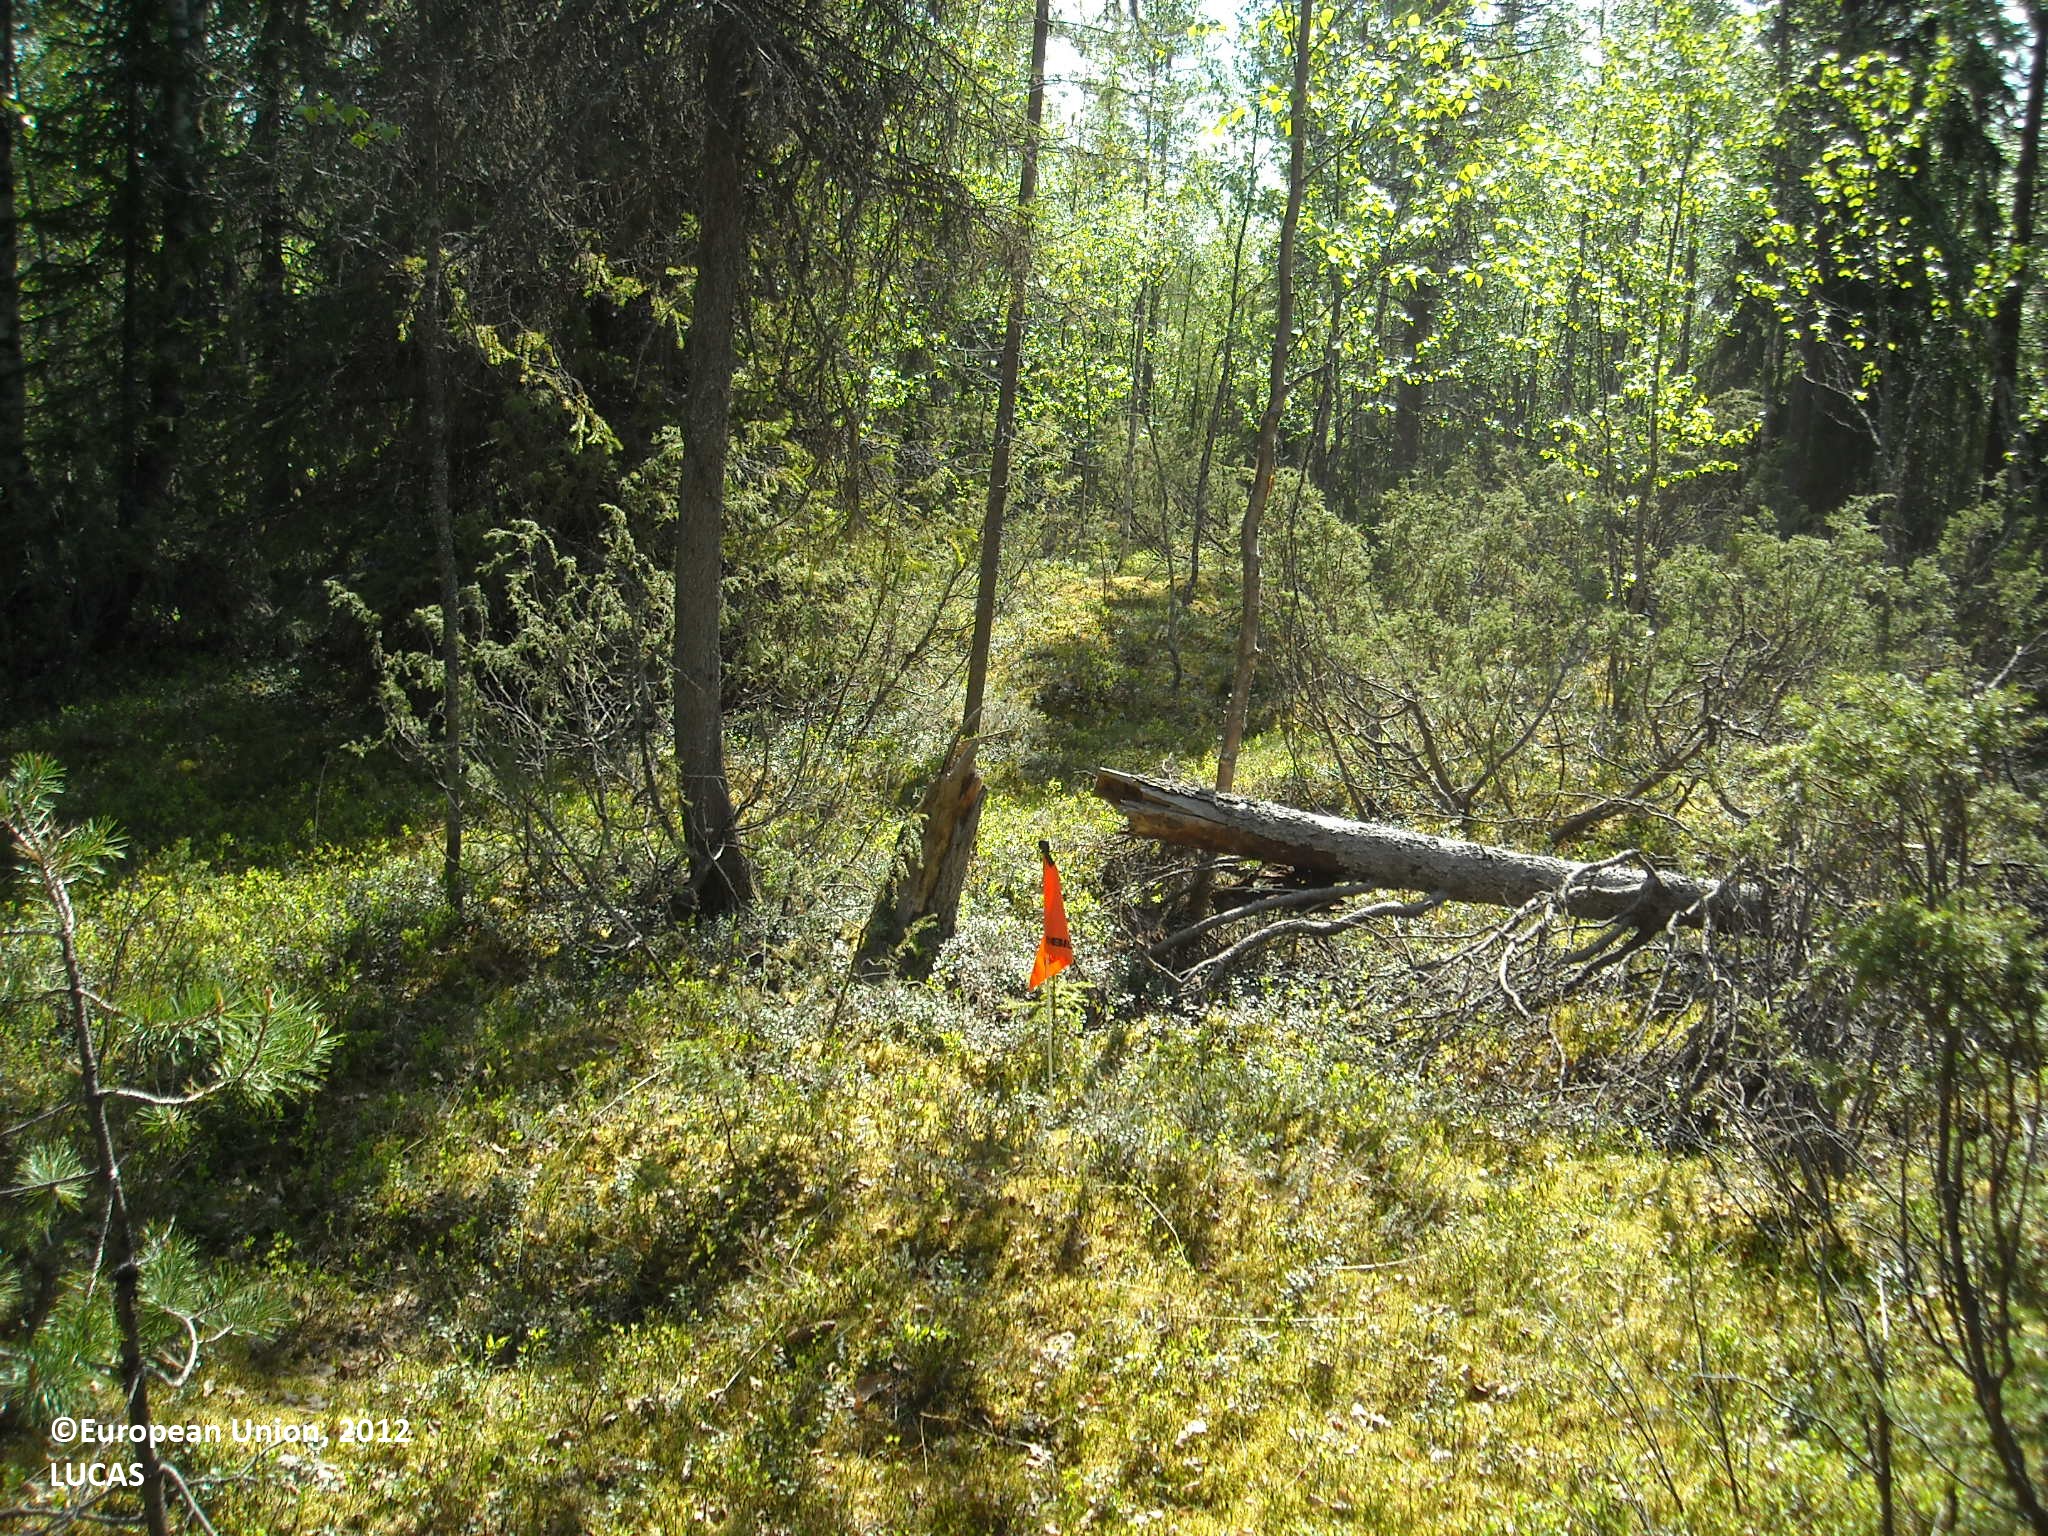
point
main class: Woodland
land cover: Other mixed woodland
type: boreal forest
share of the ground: > 75 %
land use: Forestry
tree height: > 5 m
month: June
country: FI
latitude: 65.7470
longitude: 27.9650
